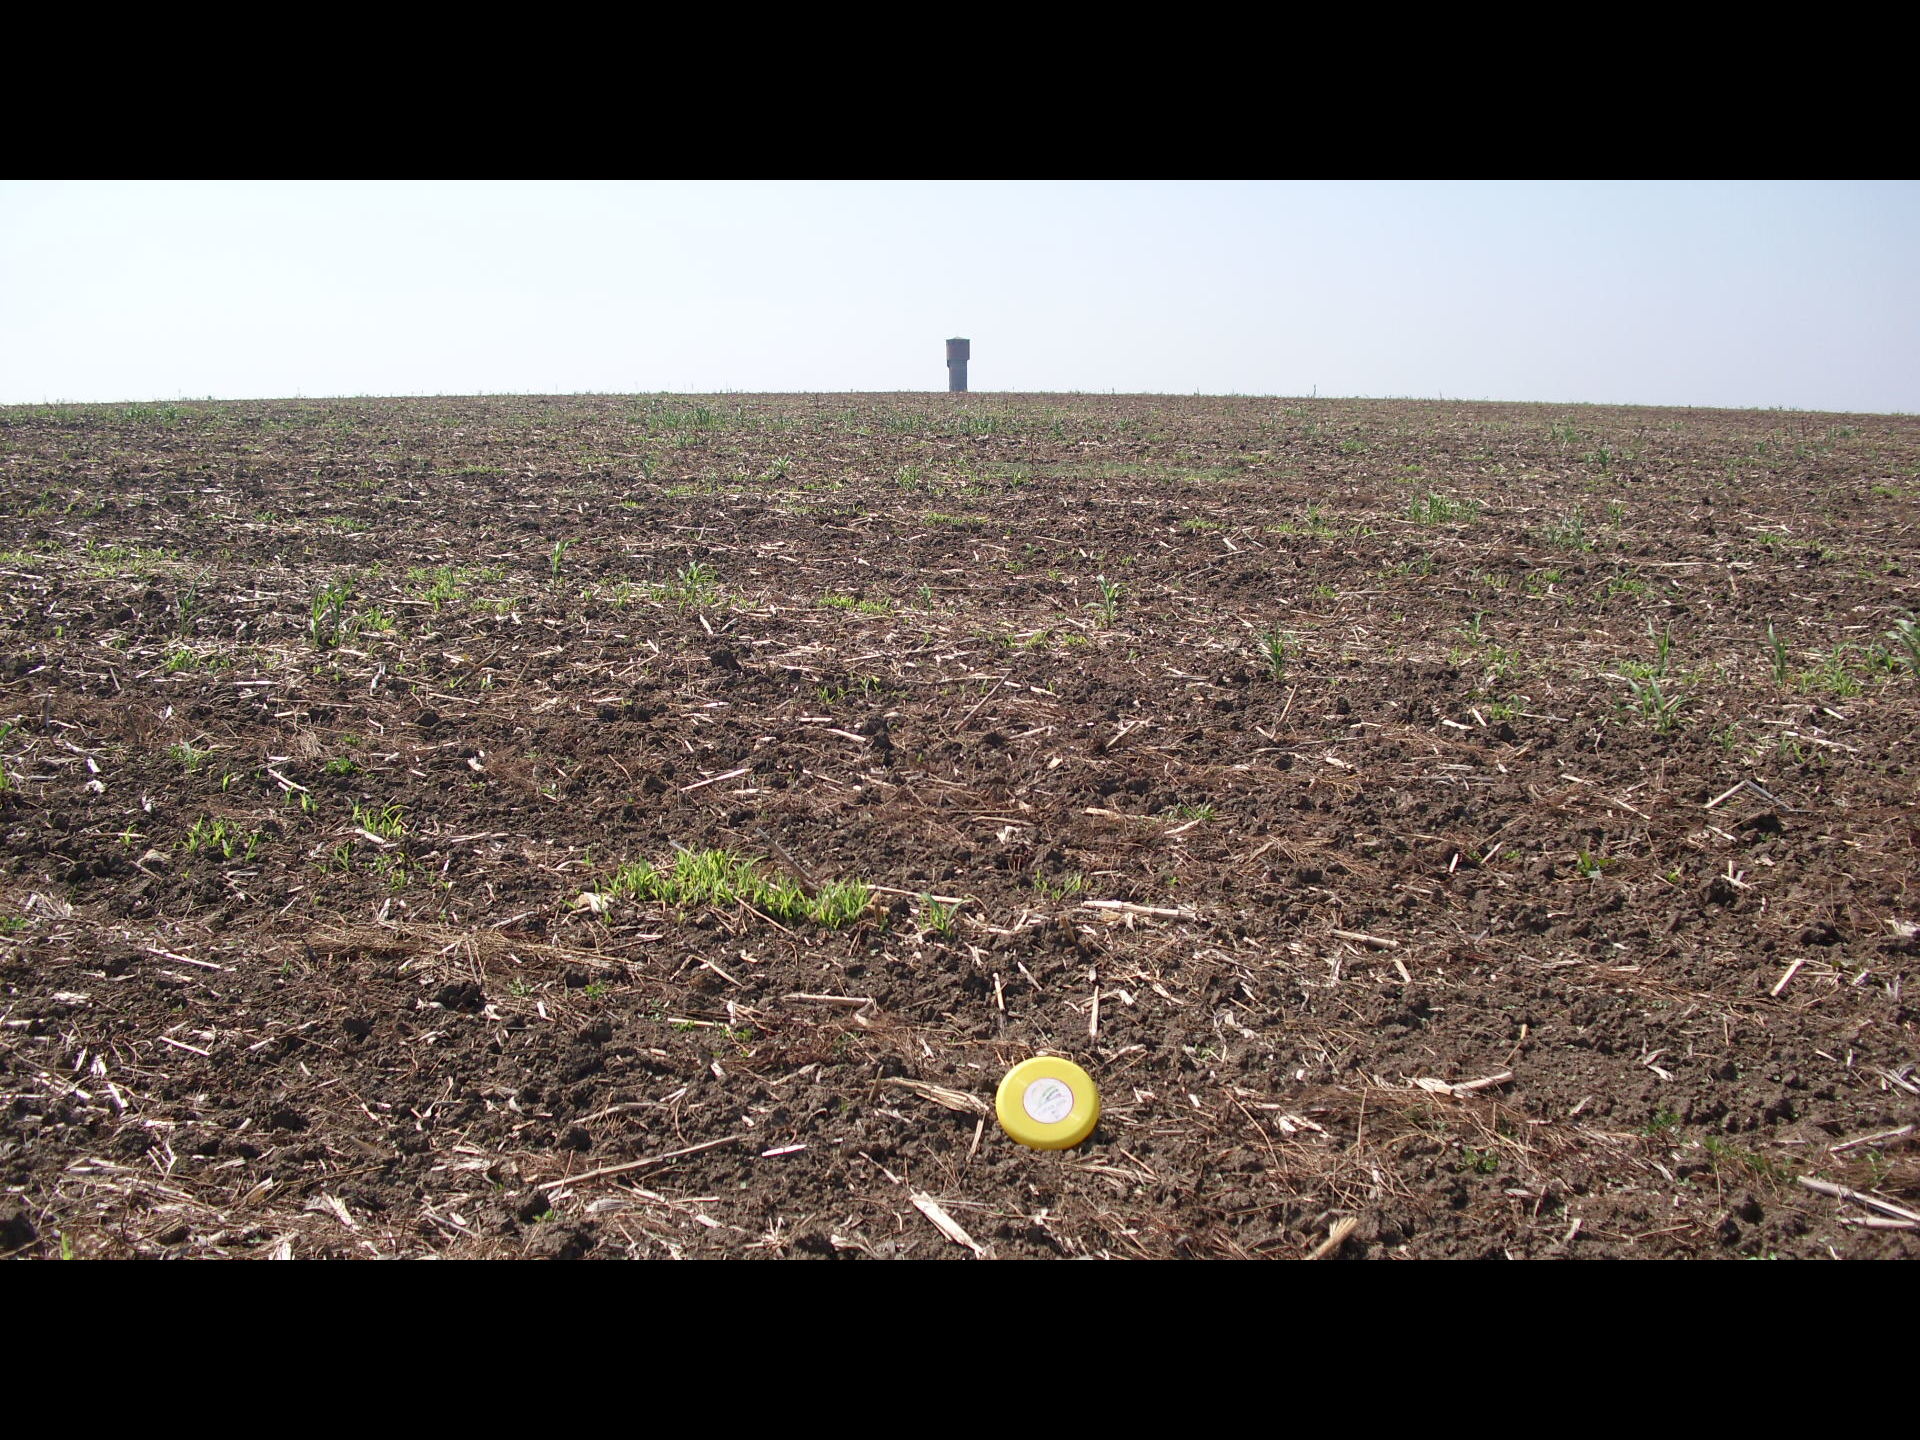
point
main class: Cropland
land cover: Maize
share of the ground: < 10 %
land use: Agriculture (excluding fallow land and kitchen gardens)
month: September
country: BG
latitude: 43.9906
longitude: 22.5160
